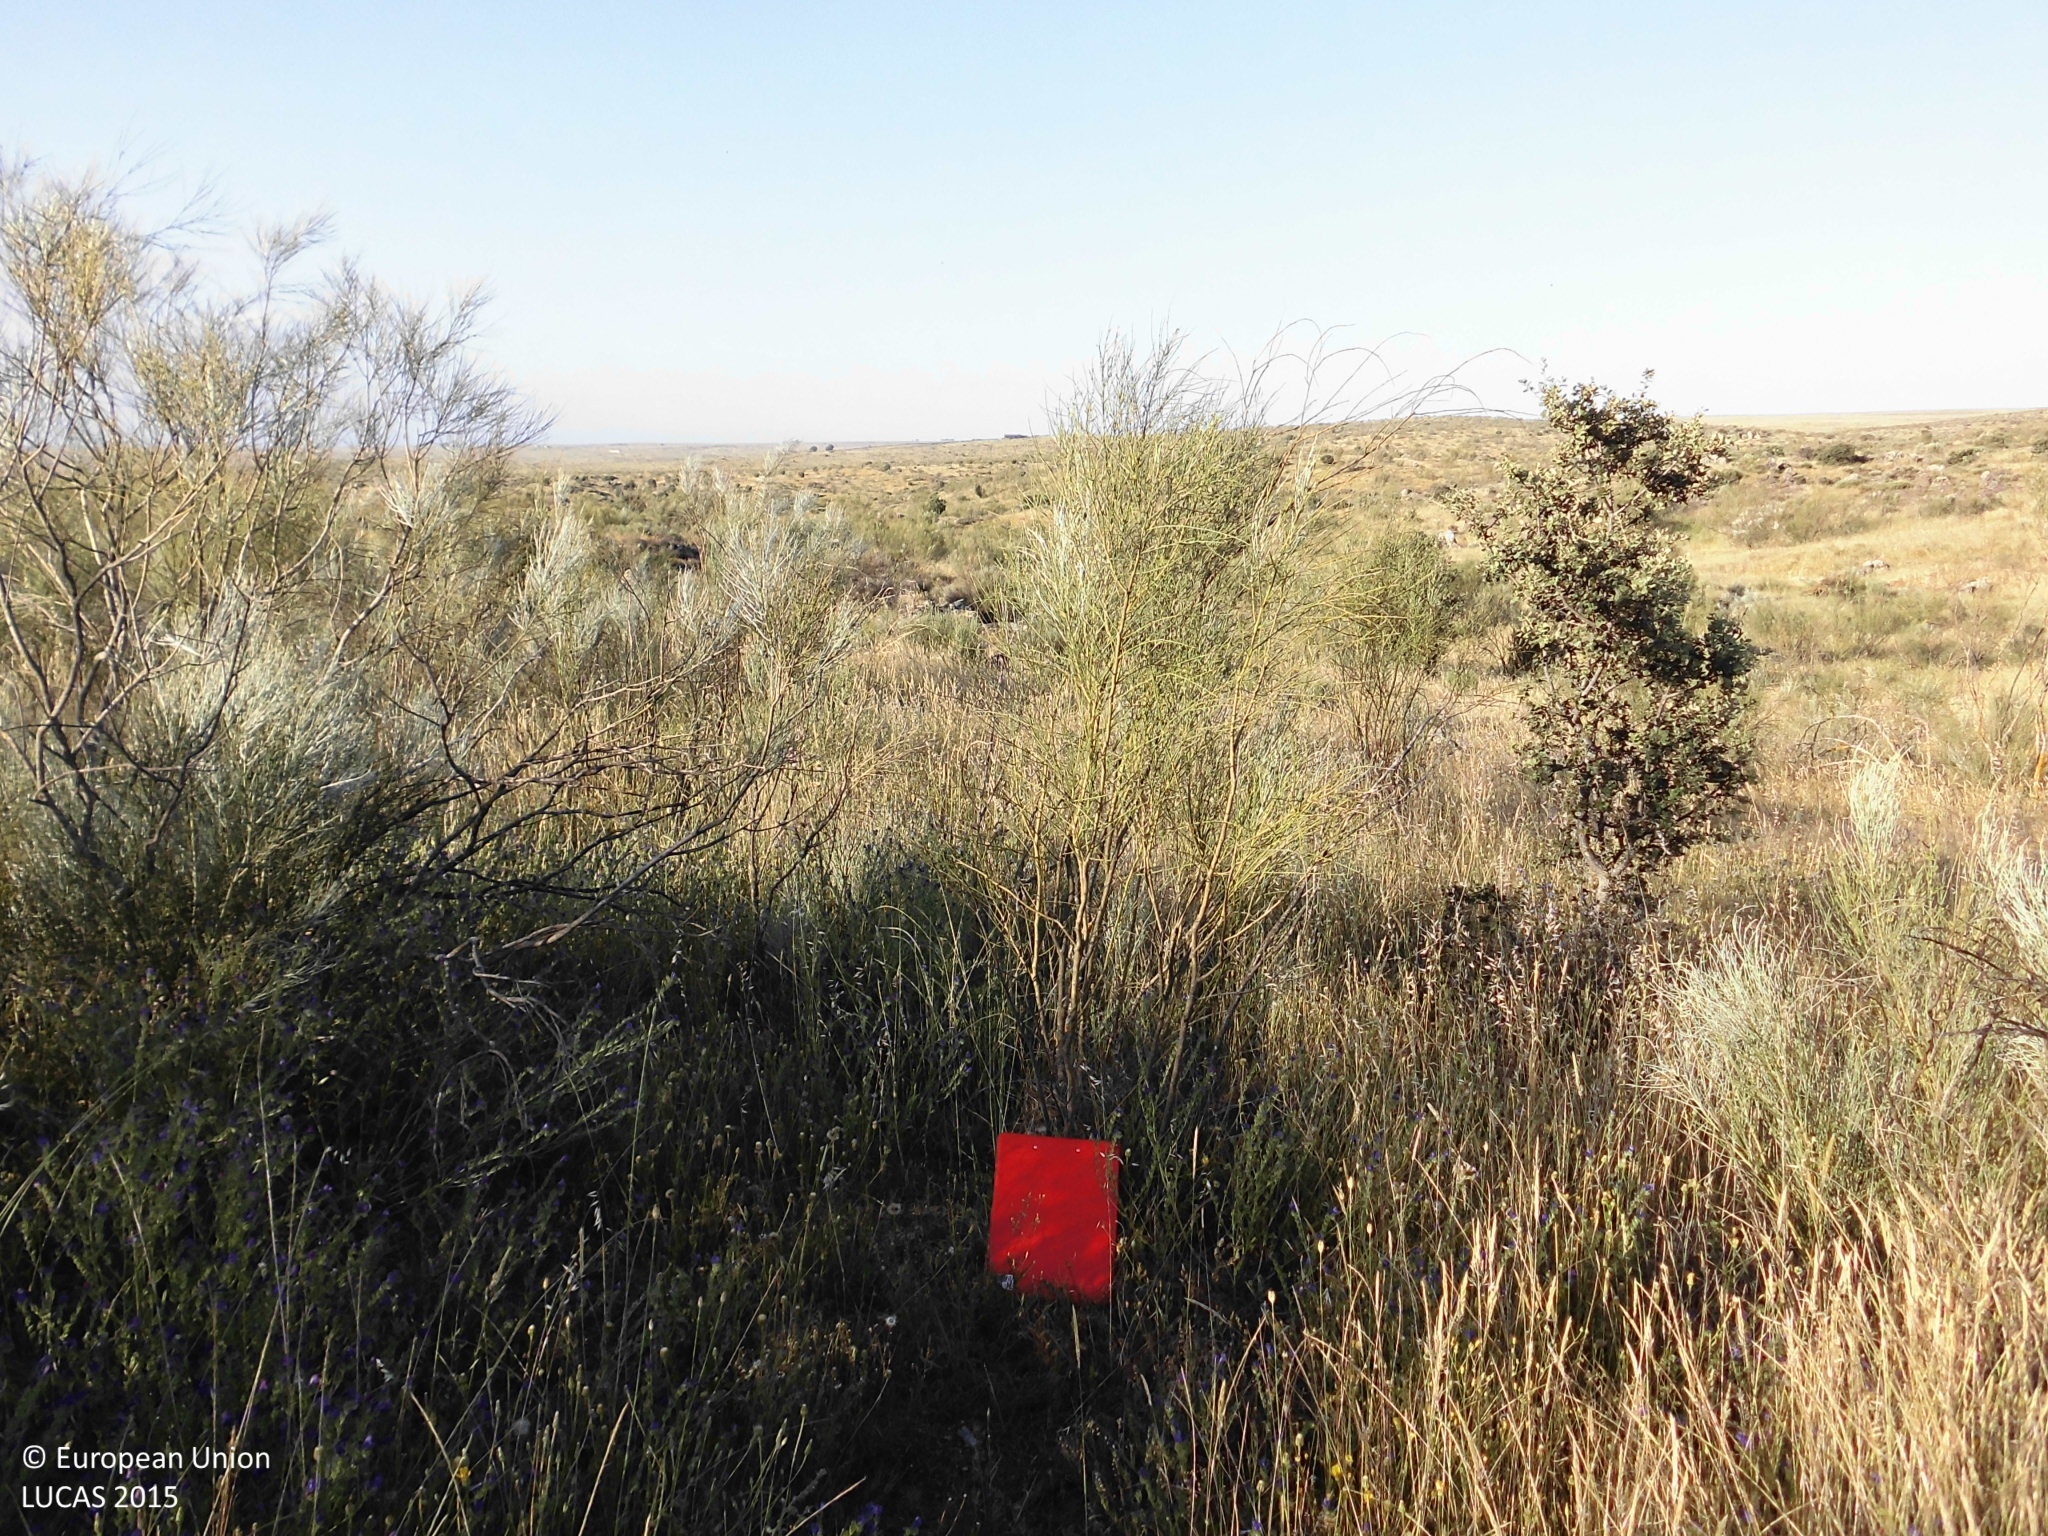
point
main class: Shrubland
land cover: Shrubland without tree cover
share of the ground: 25 - 50 %
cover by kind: herbaceous plants 75 %, shrubs 25 %
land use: Agriculture (excluding fallow land and kitchen gardens)
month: May
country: ES
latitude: 39.4886
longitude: -6.0490
